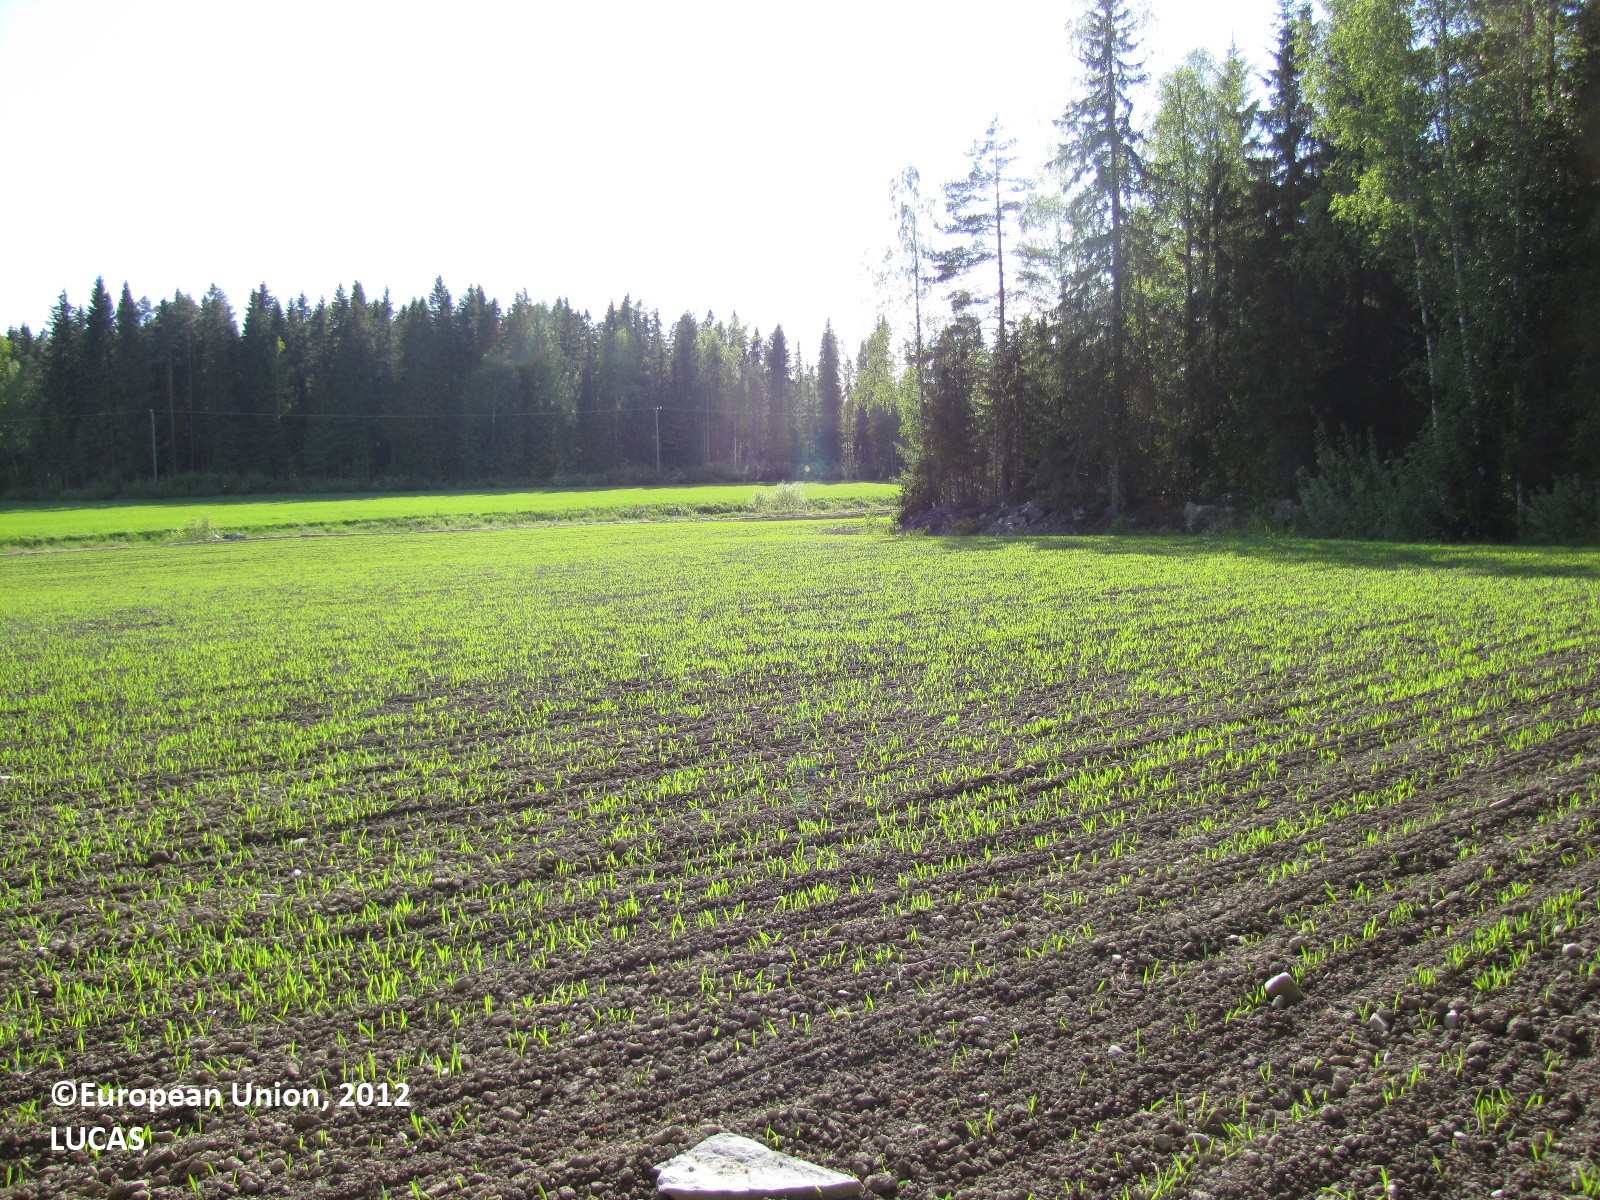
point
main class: Cropland
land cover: Barley
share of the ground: 25 - 50 %
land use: Agriculture (excluding fallow land and kitchen gardens)
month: June
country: FI
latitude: 61.2415
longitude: 22.9850
